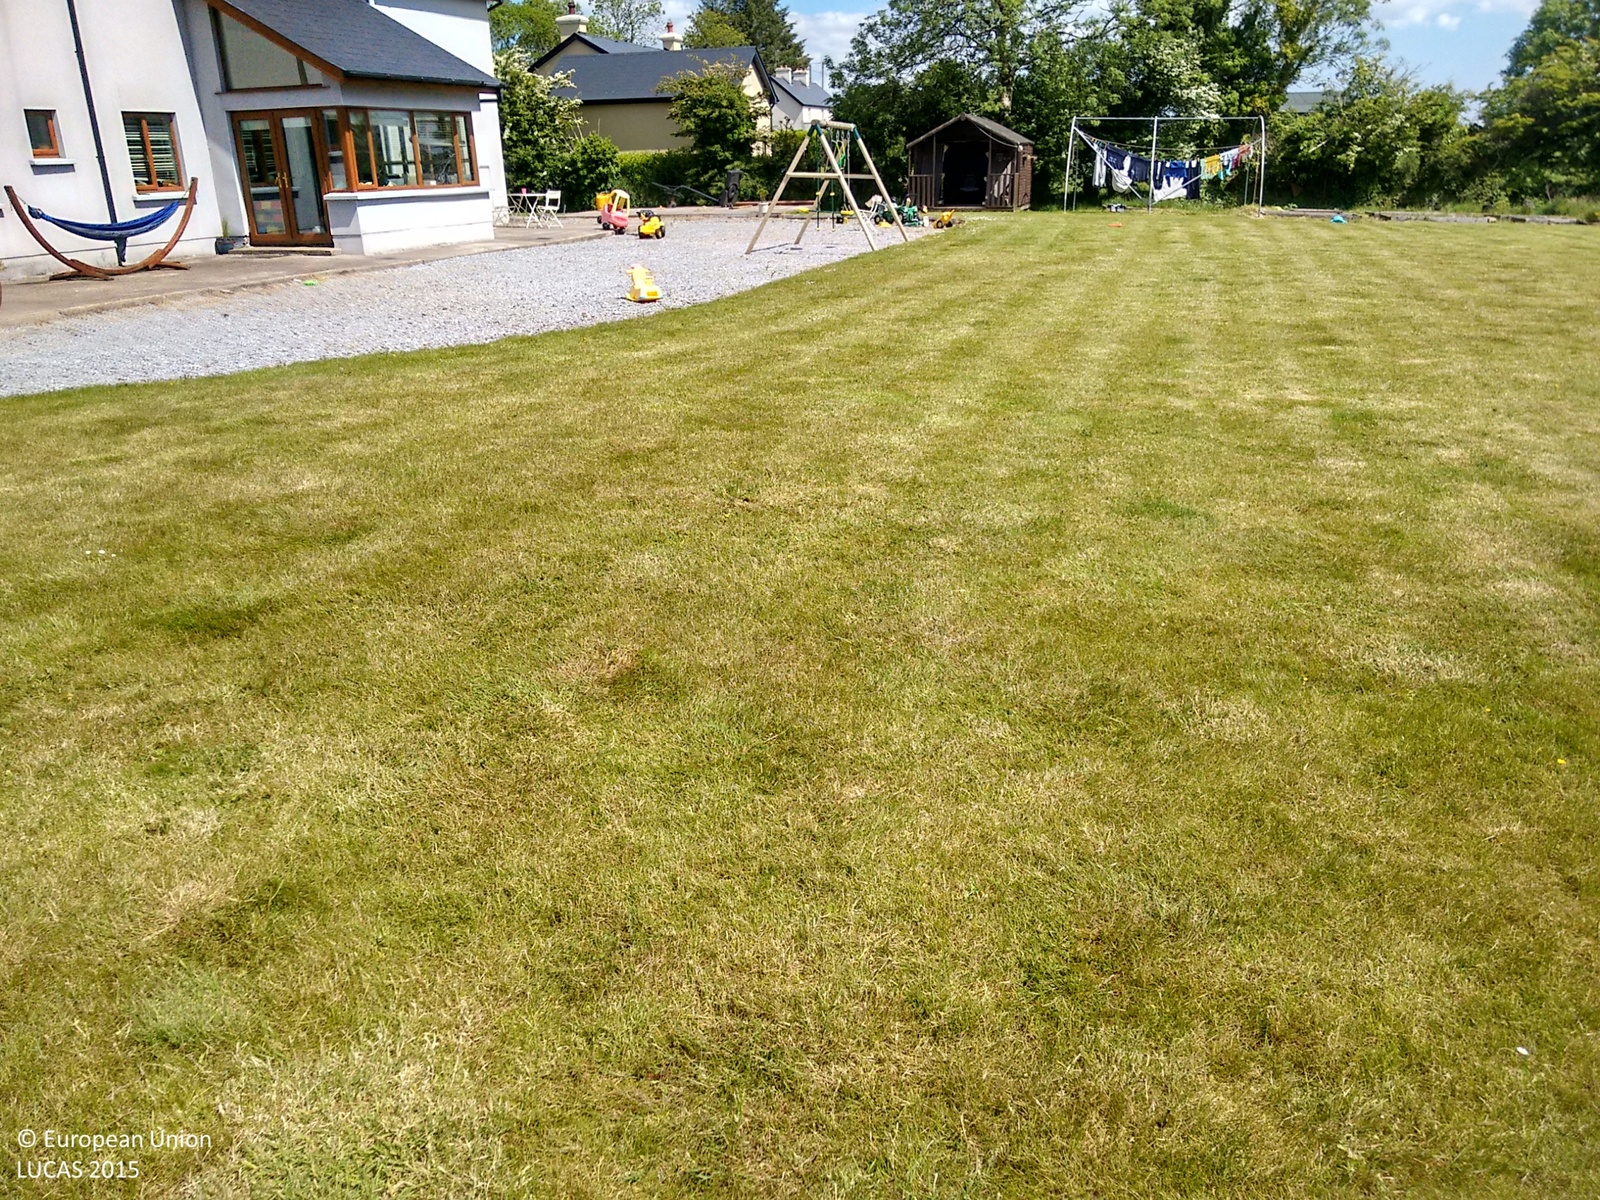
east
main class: Grassland
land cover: Grassland without tree/shrub cover
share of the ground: > 75 %
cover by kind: herbaceous plants 95 %, shrubs 5 %
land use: Agriculture (excluding fallow land and kitchen gardens)
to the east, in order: Grassland without tree/shrub cover; Artificial constructions in urban areas; Lines of trees; Grassland without tree/shrub cover; Fences; Electric lines; Grassland without tree/shrub cover
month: June
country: IE
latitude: 51.9785
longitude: -8.8270
